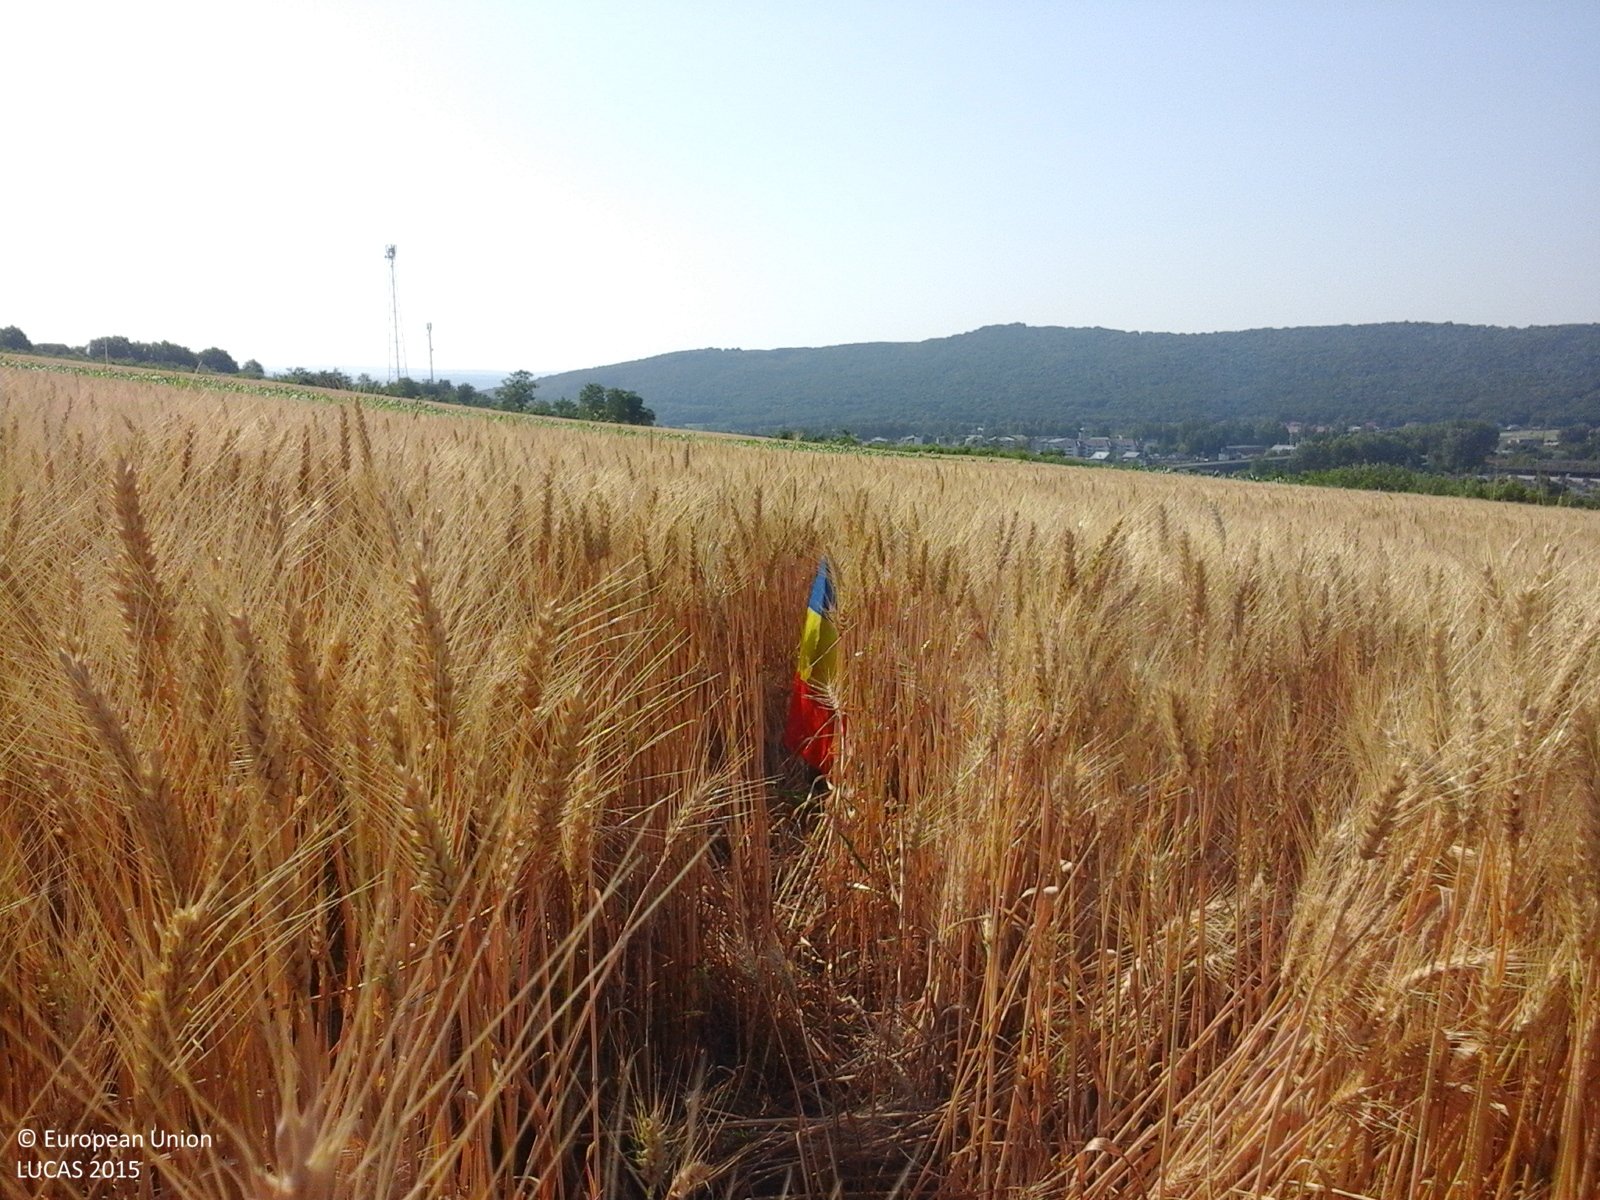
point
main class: Cropland
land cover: Common wheat
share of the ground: > 75 %
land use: Agriculture (excluding fallow land and kitchen gardens)
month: June
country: RO
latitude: 46.6308
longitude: 27.6853
